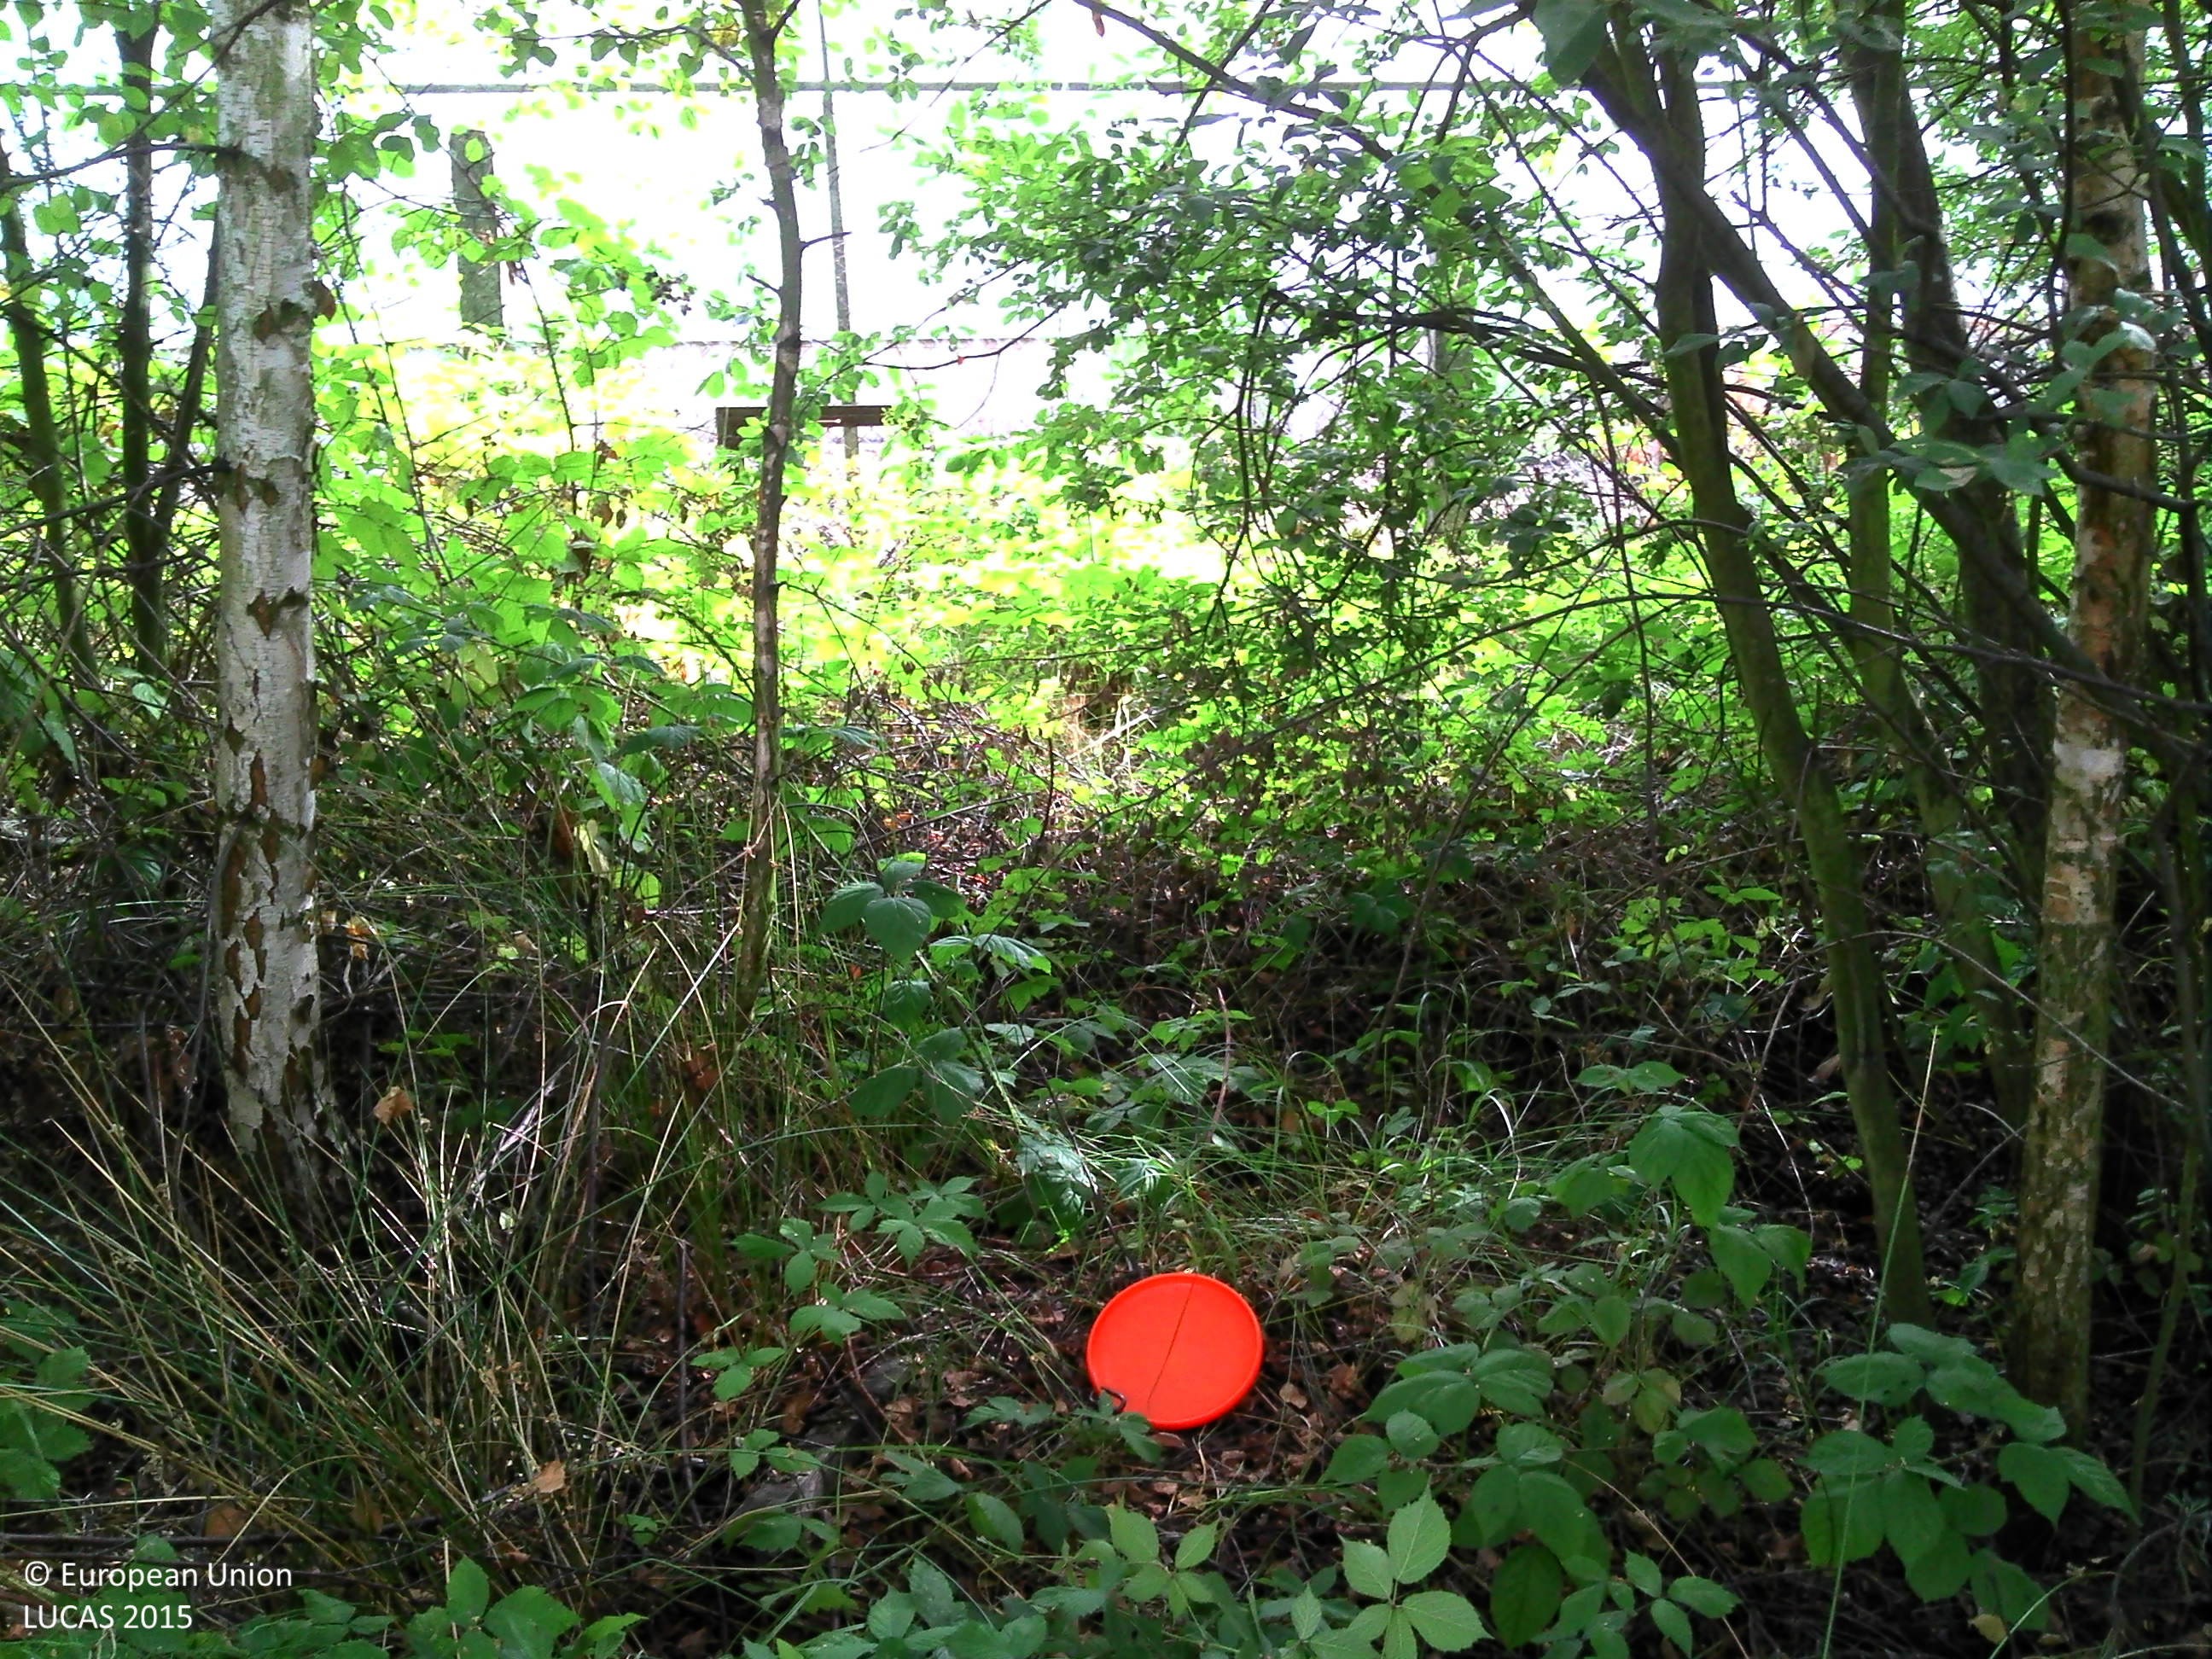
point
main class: Woodland
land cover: Broadleaved woodland
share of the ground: > 75 %
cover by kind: broadleaved forest trees 80 %, herbaceous plants 20 %
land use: Semi-natural and natural areas not in use
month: June
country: BE
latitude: 51.0722
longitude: 5.1593
